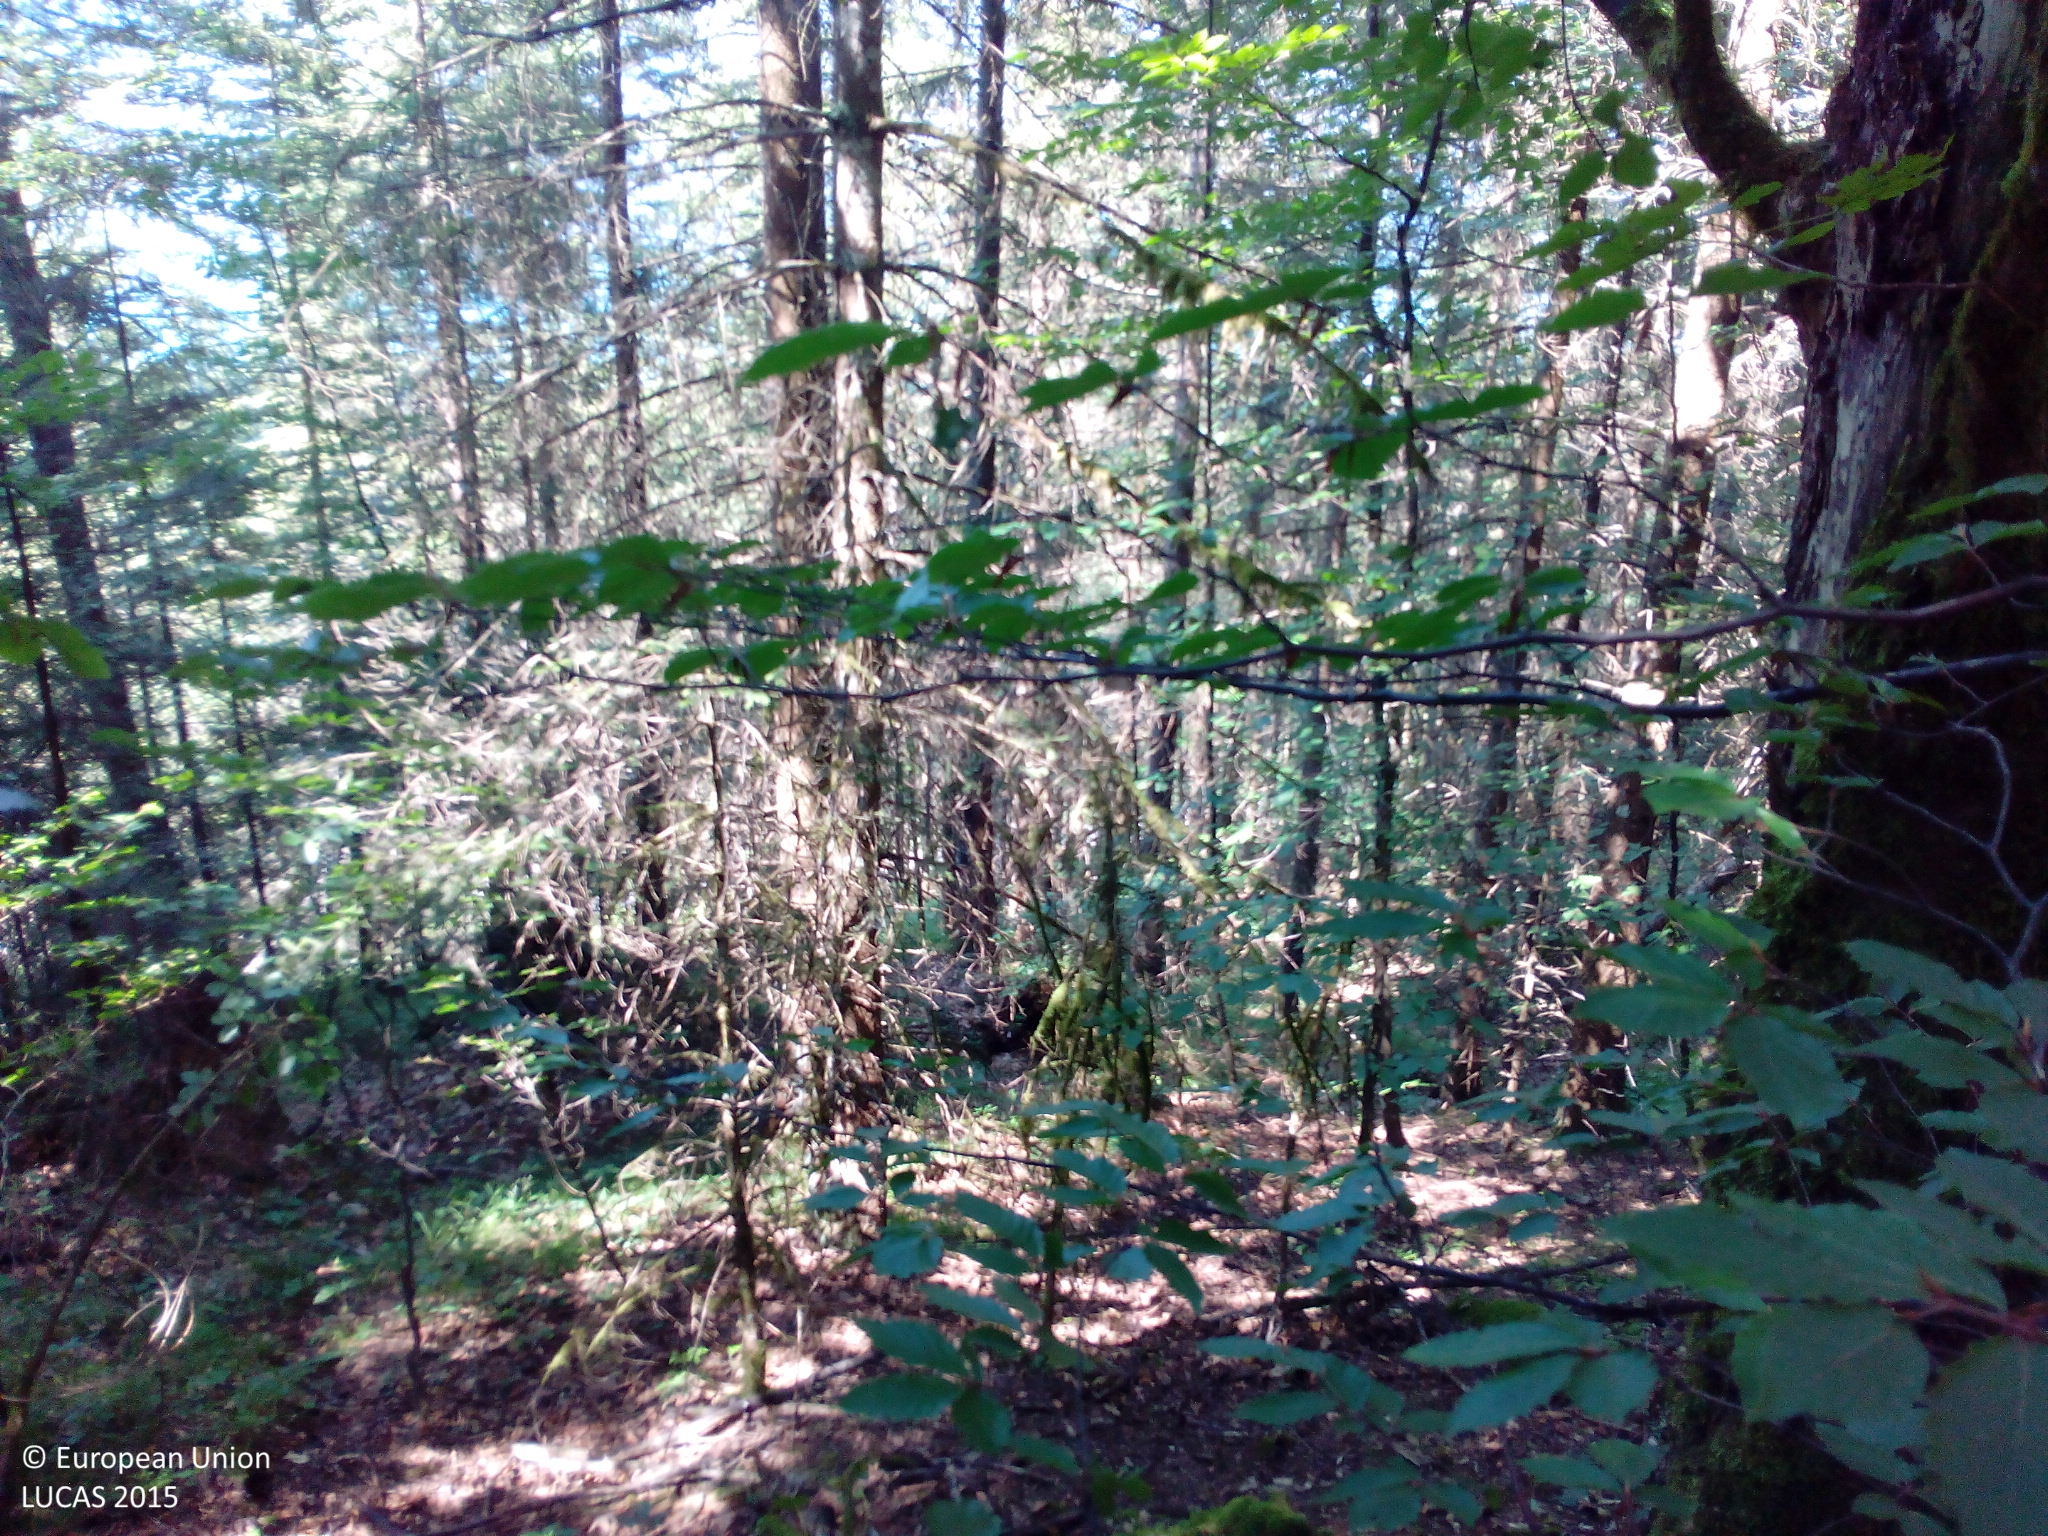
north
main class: Woodland
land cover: Spruce dominated coniferous woodland
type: hemiboreal forest and nemoral coniferous forest and mixed broadleaved-coniferous forest
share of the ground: > 75 %
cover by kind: coniferous forest trees 90 %, broadleaved forest trees 10 %
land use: Forestry
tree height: > 5 m
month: August
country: DE
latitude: 47.5674
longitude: 11.3414
